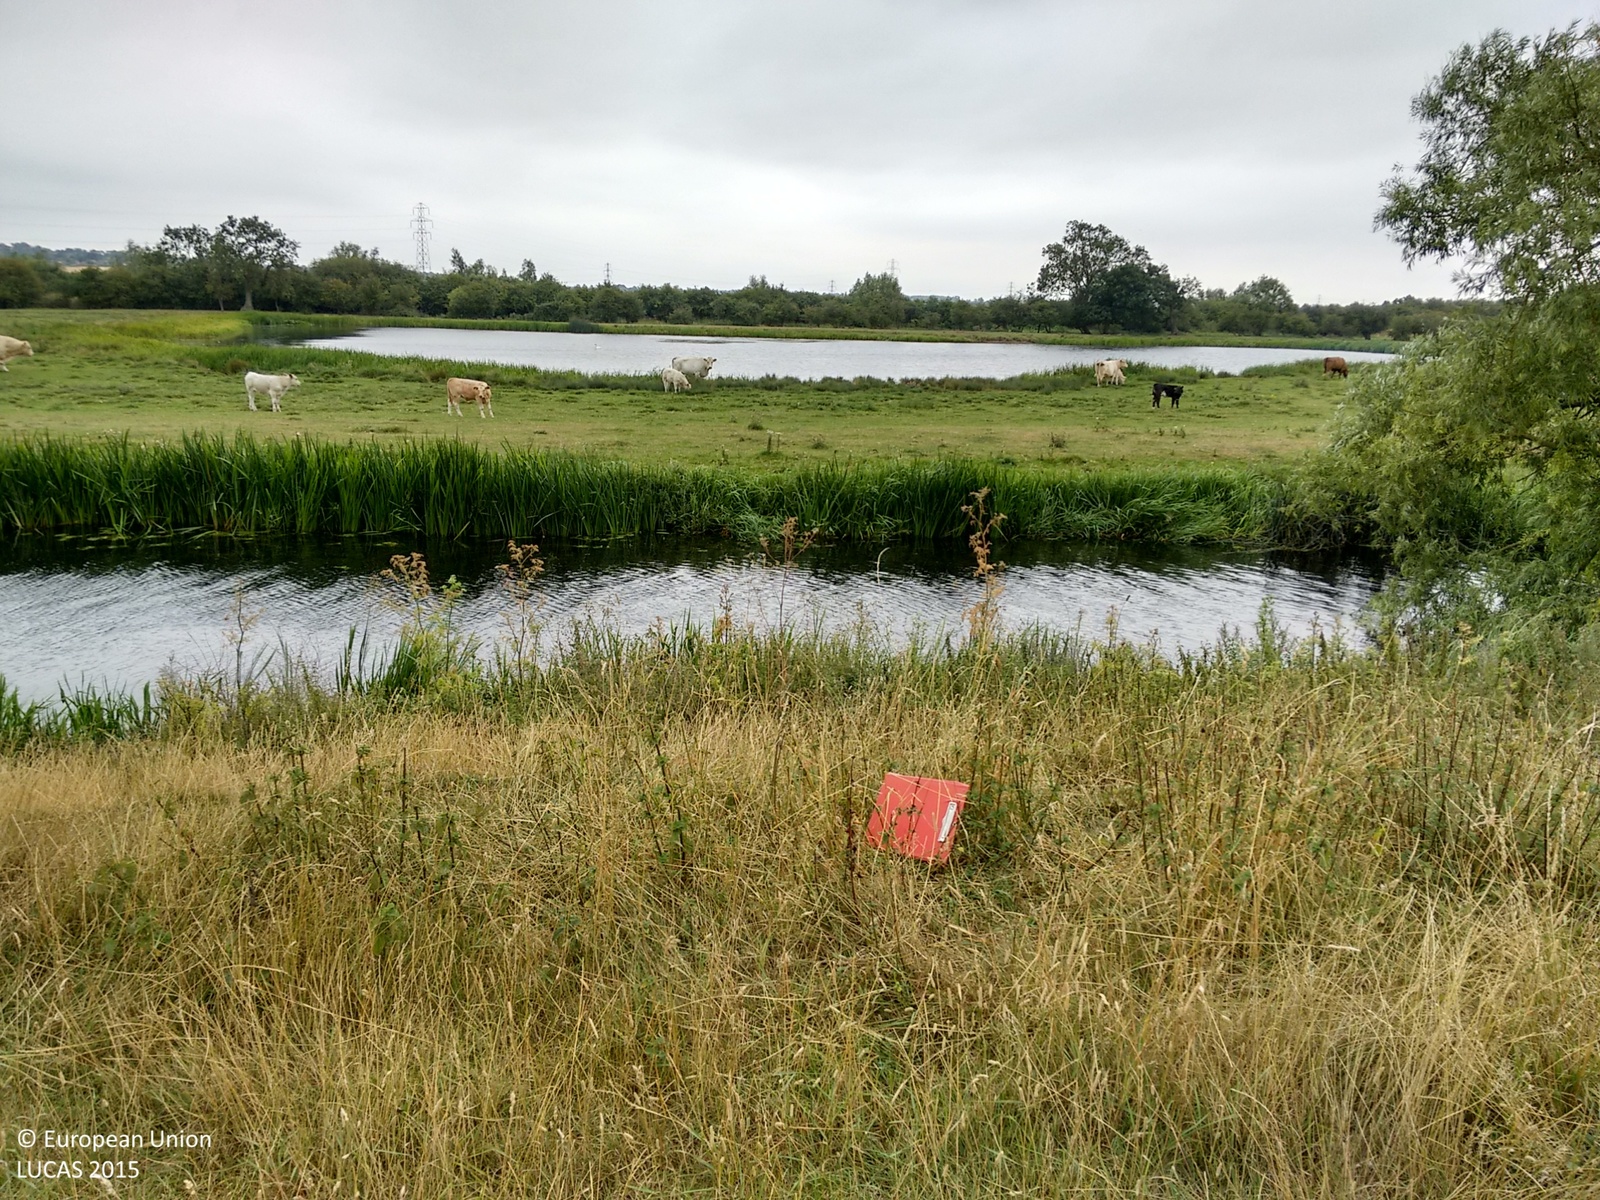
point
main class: Grassland
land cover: Grassland without tree/shrub cover
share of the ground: > 75 %
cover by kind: herbaceous plants 100 %
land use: Agriculture (excluding fallow land and kitchen gardens)
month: August
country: GB
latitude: 52.2738
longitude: -0.6951
